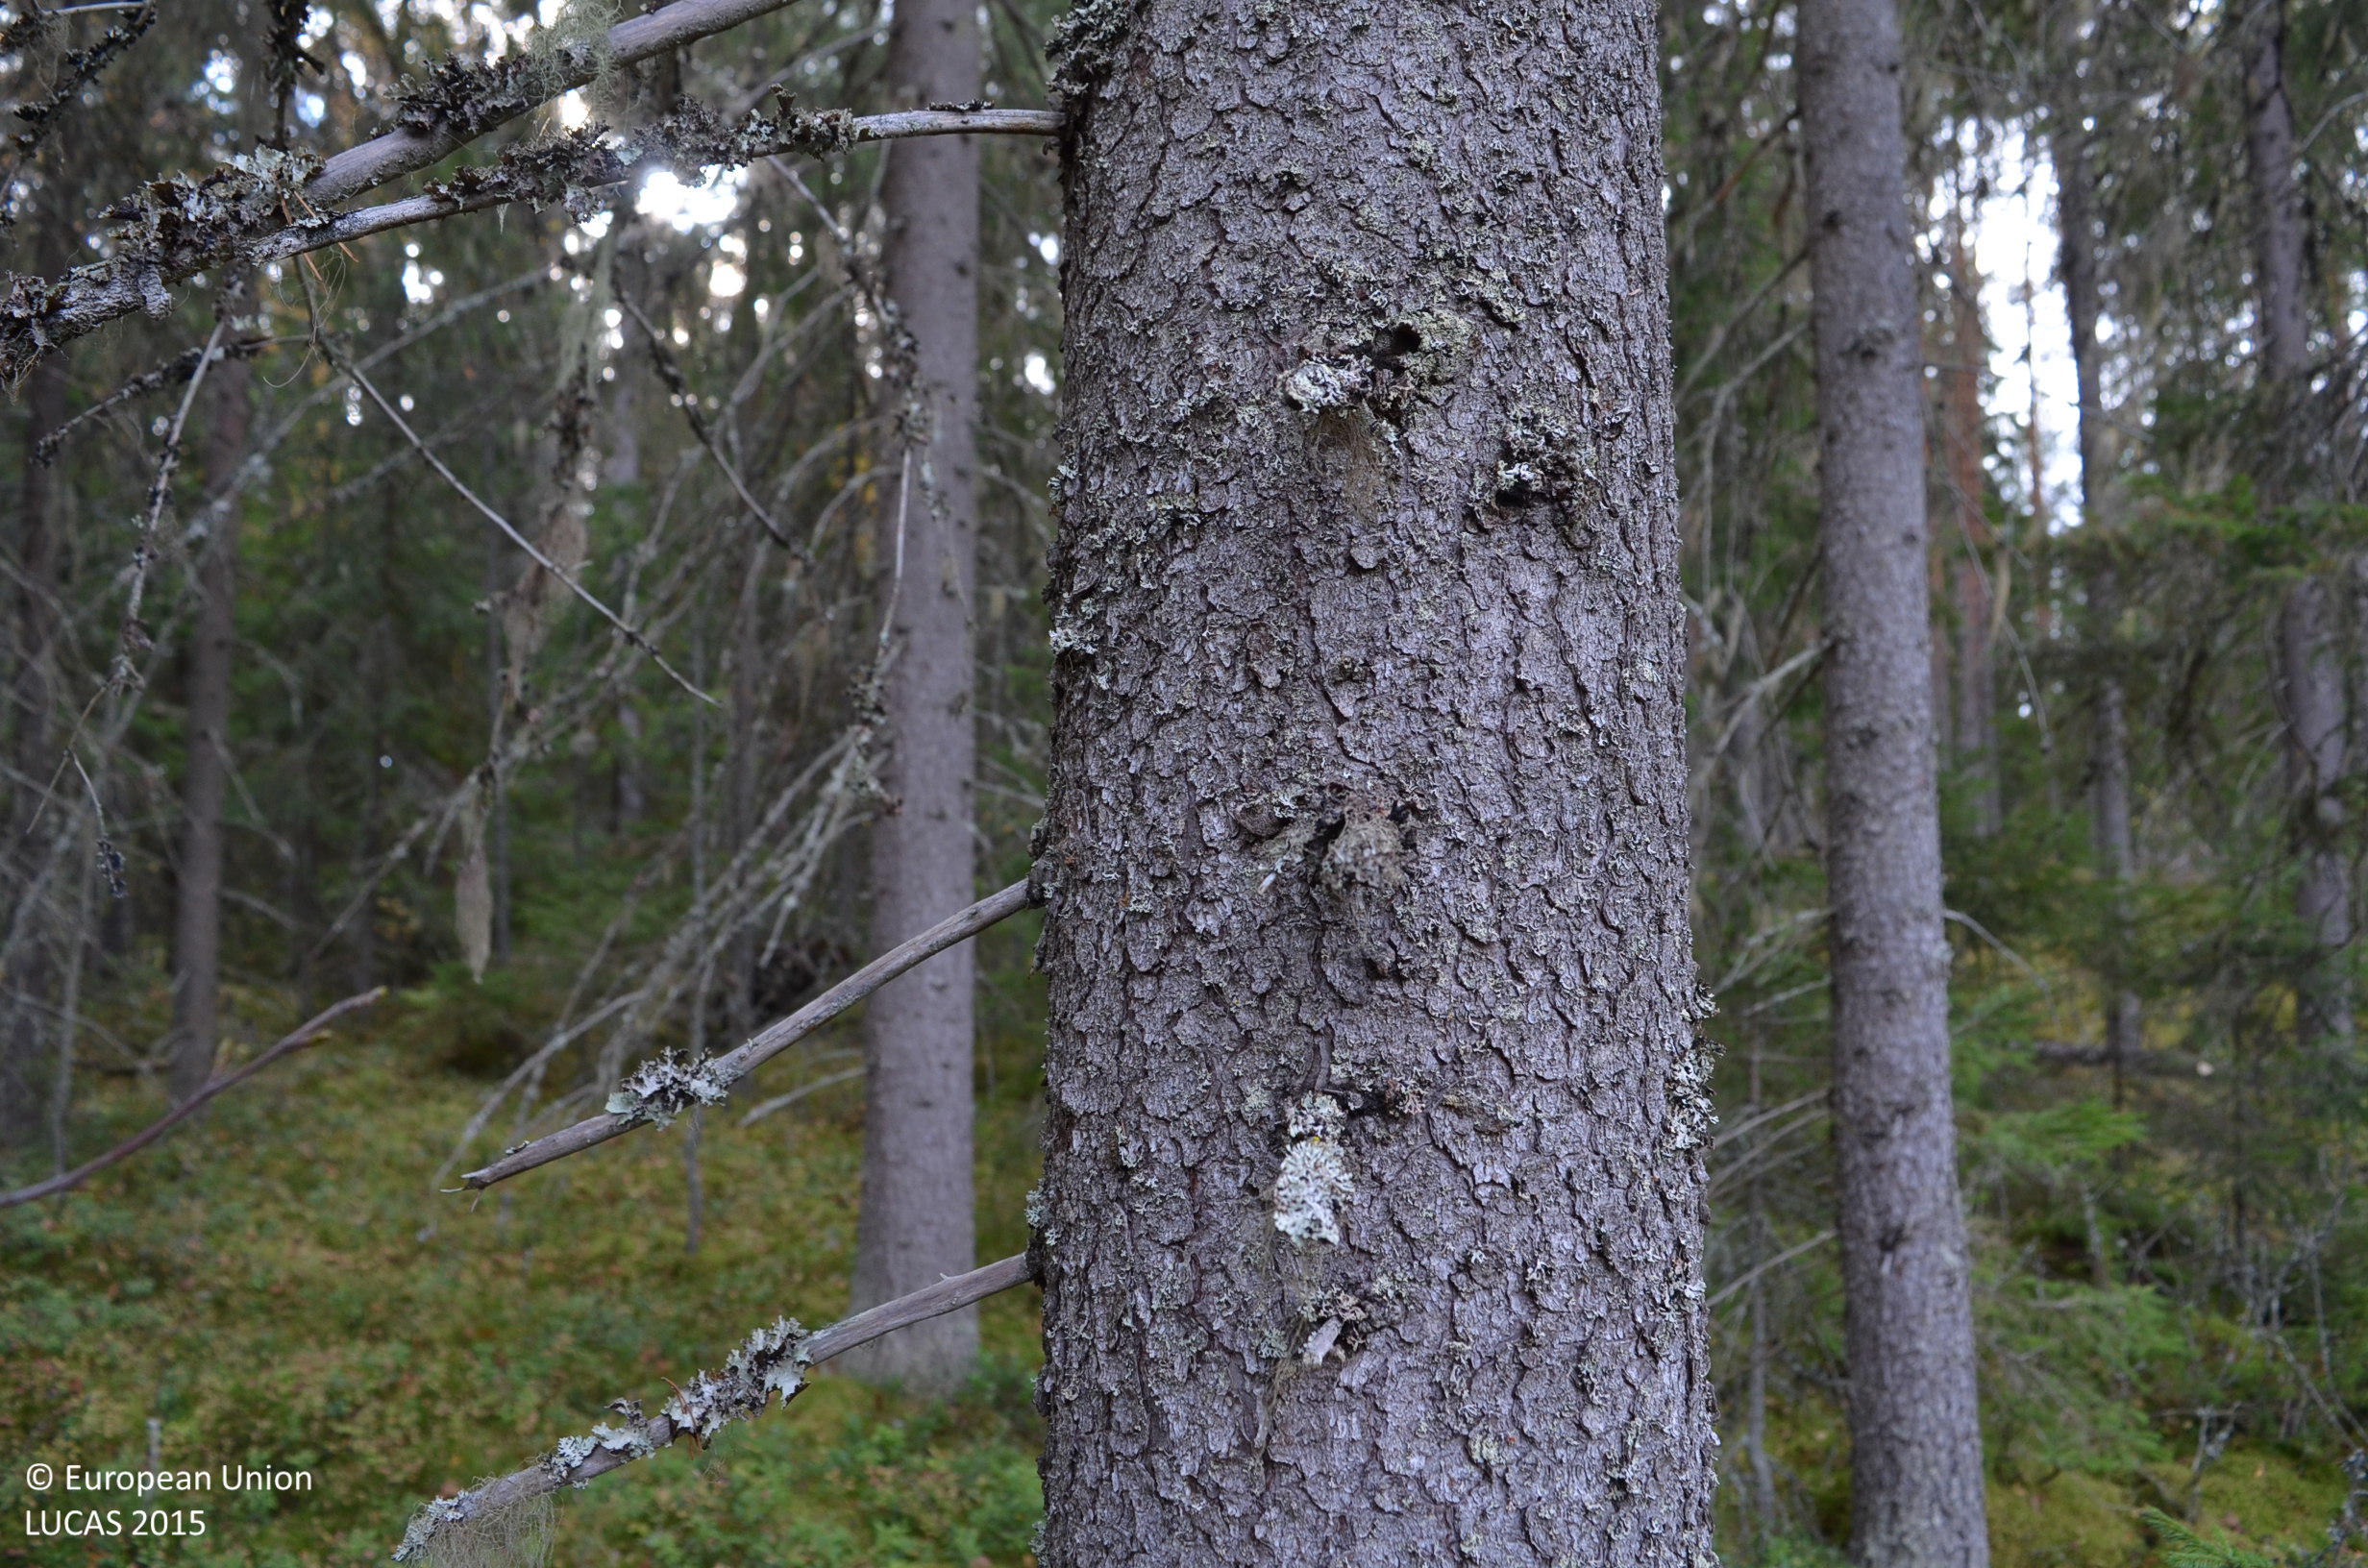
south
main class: Woodland
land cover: Other coniferous woodland
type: boreal forest
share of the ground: > 75 %
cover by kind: coniferous forest trees 70 %, lichens and mosses 15 %, shrubs 10 %, broadleaved forest trees 5 %
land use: Forestry
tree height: > 5 m
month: October
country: FI
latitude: 61.6703
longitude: 23.8938
